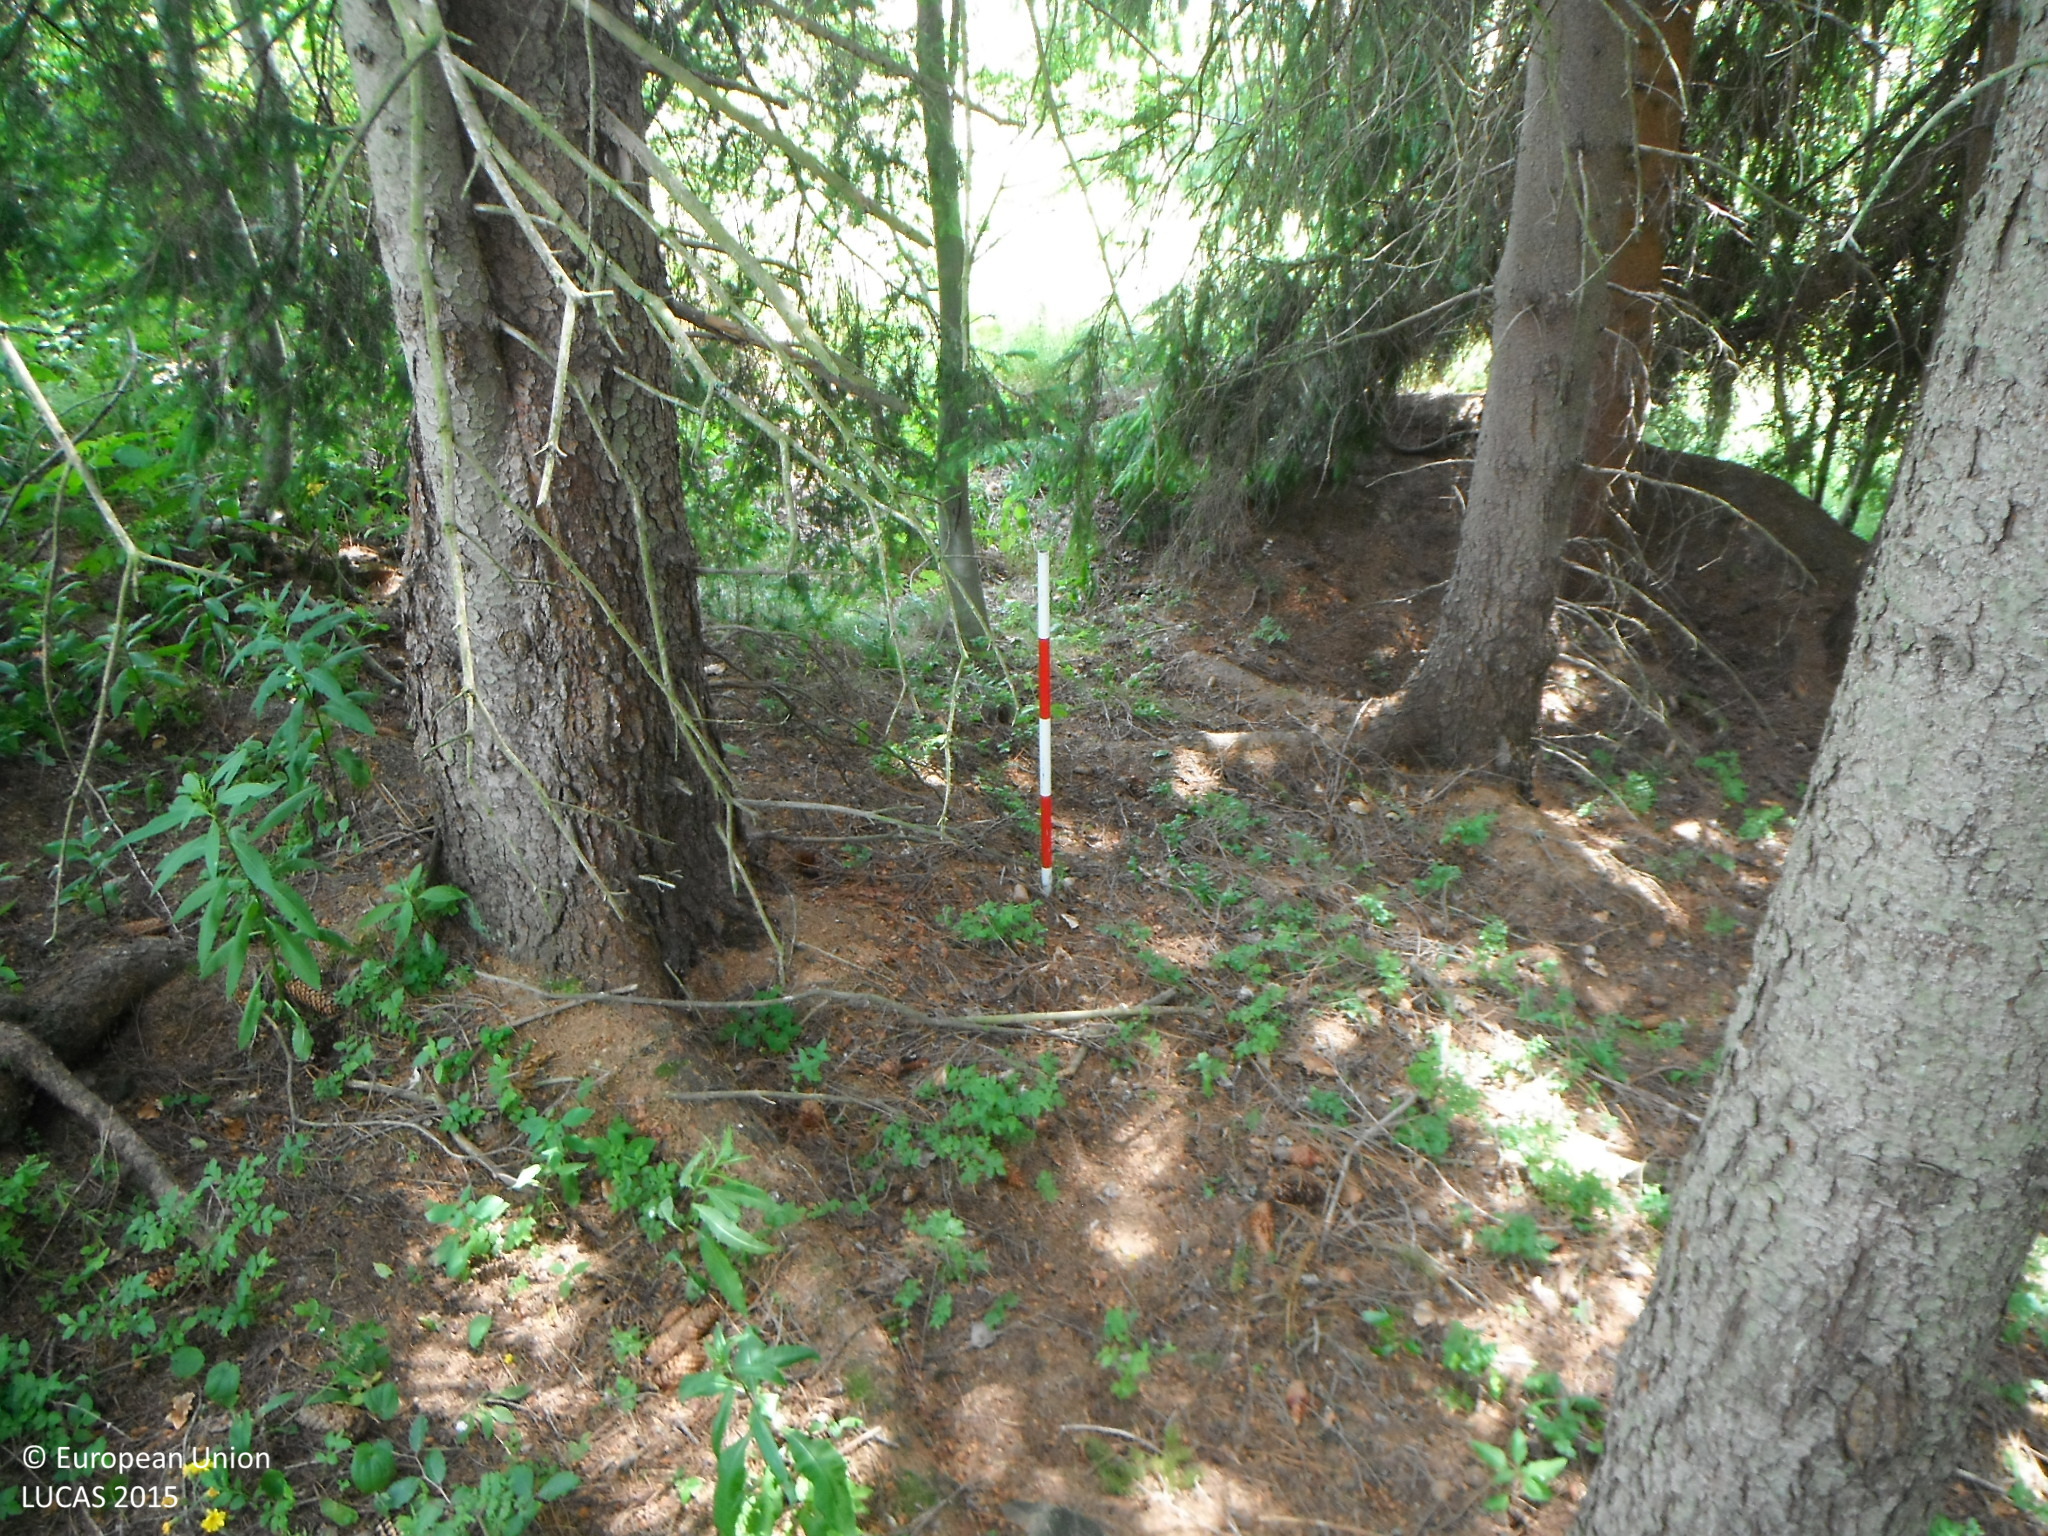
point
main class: Woodland
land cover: Spruce dominated coniferous woodland
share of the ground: > 75 %
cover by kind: coniferous forest trees 90 %, broadleaved forest trees 10 %
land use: Forestry
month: July
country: SK
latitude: 49.4074
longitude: 19.2722
